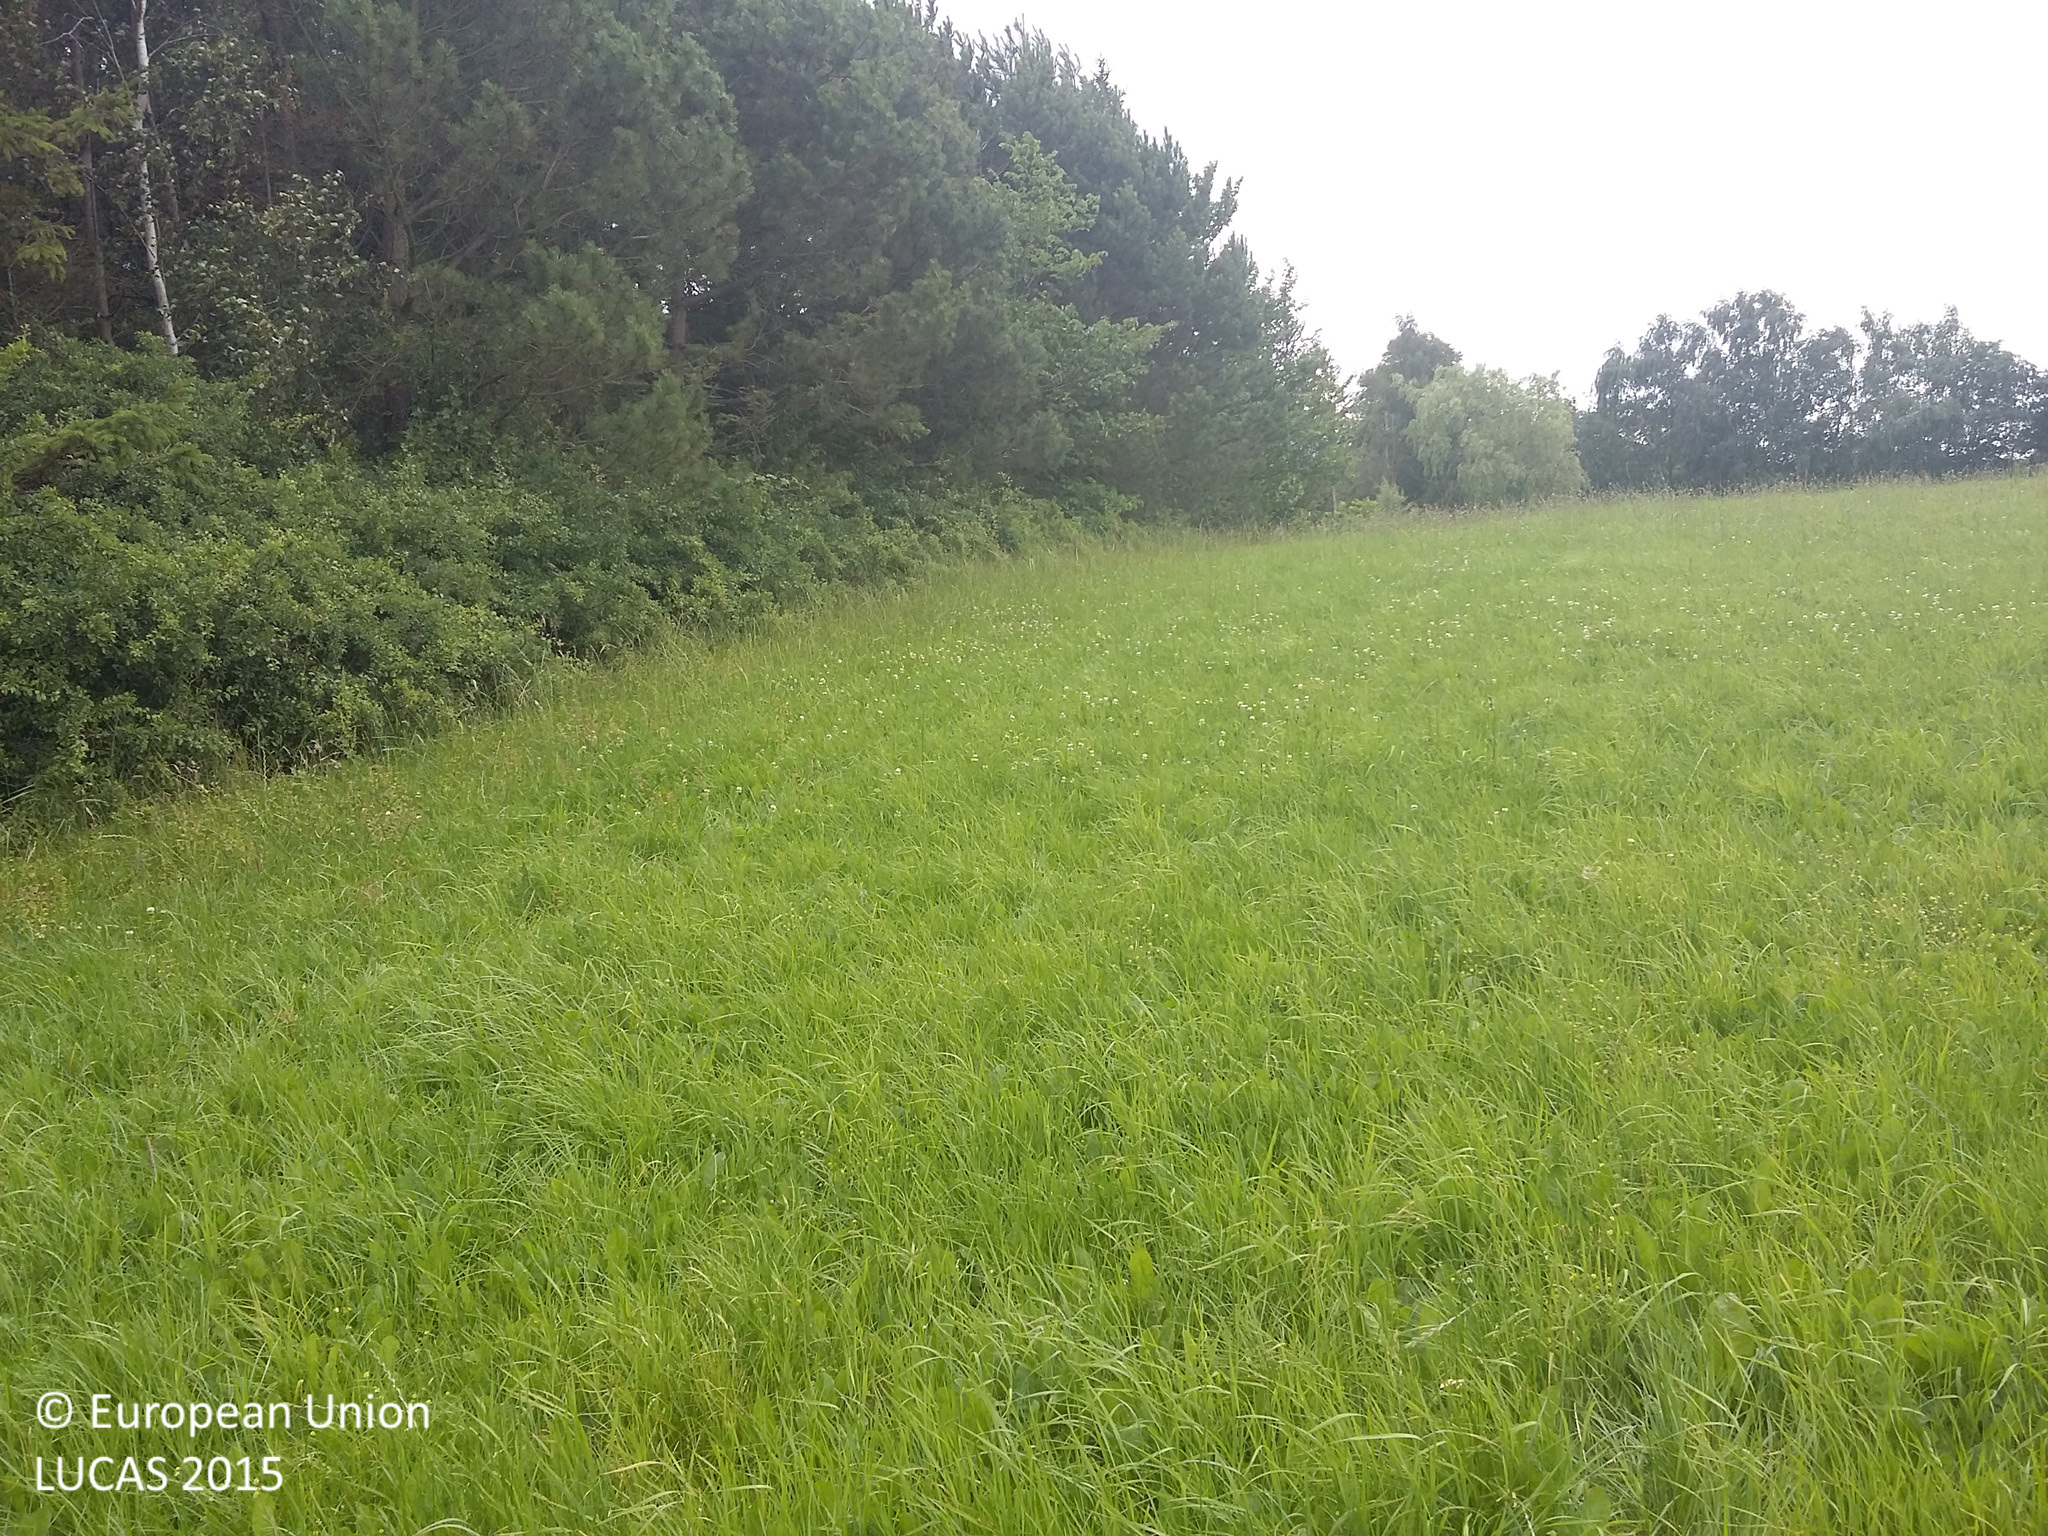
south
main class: Grassland
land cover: Grassland without tree/shrub cover
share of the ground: > 75 %
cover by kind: herbaceous plants 100 %
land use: Agriculture (excluding fallow land and kitchen gardens)
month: July
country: DK
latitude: 56.0605
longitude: 12.2302
